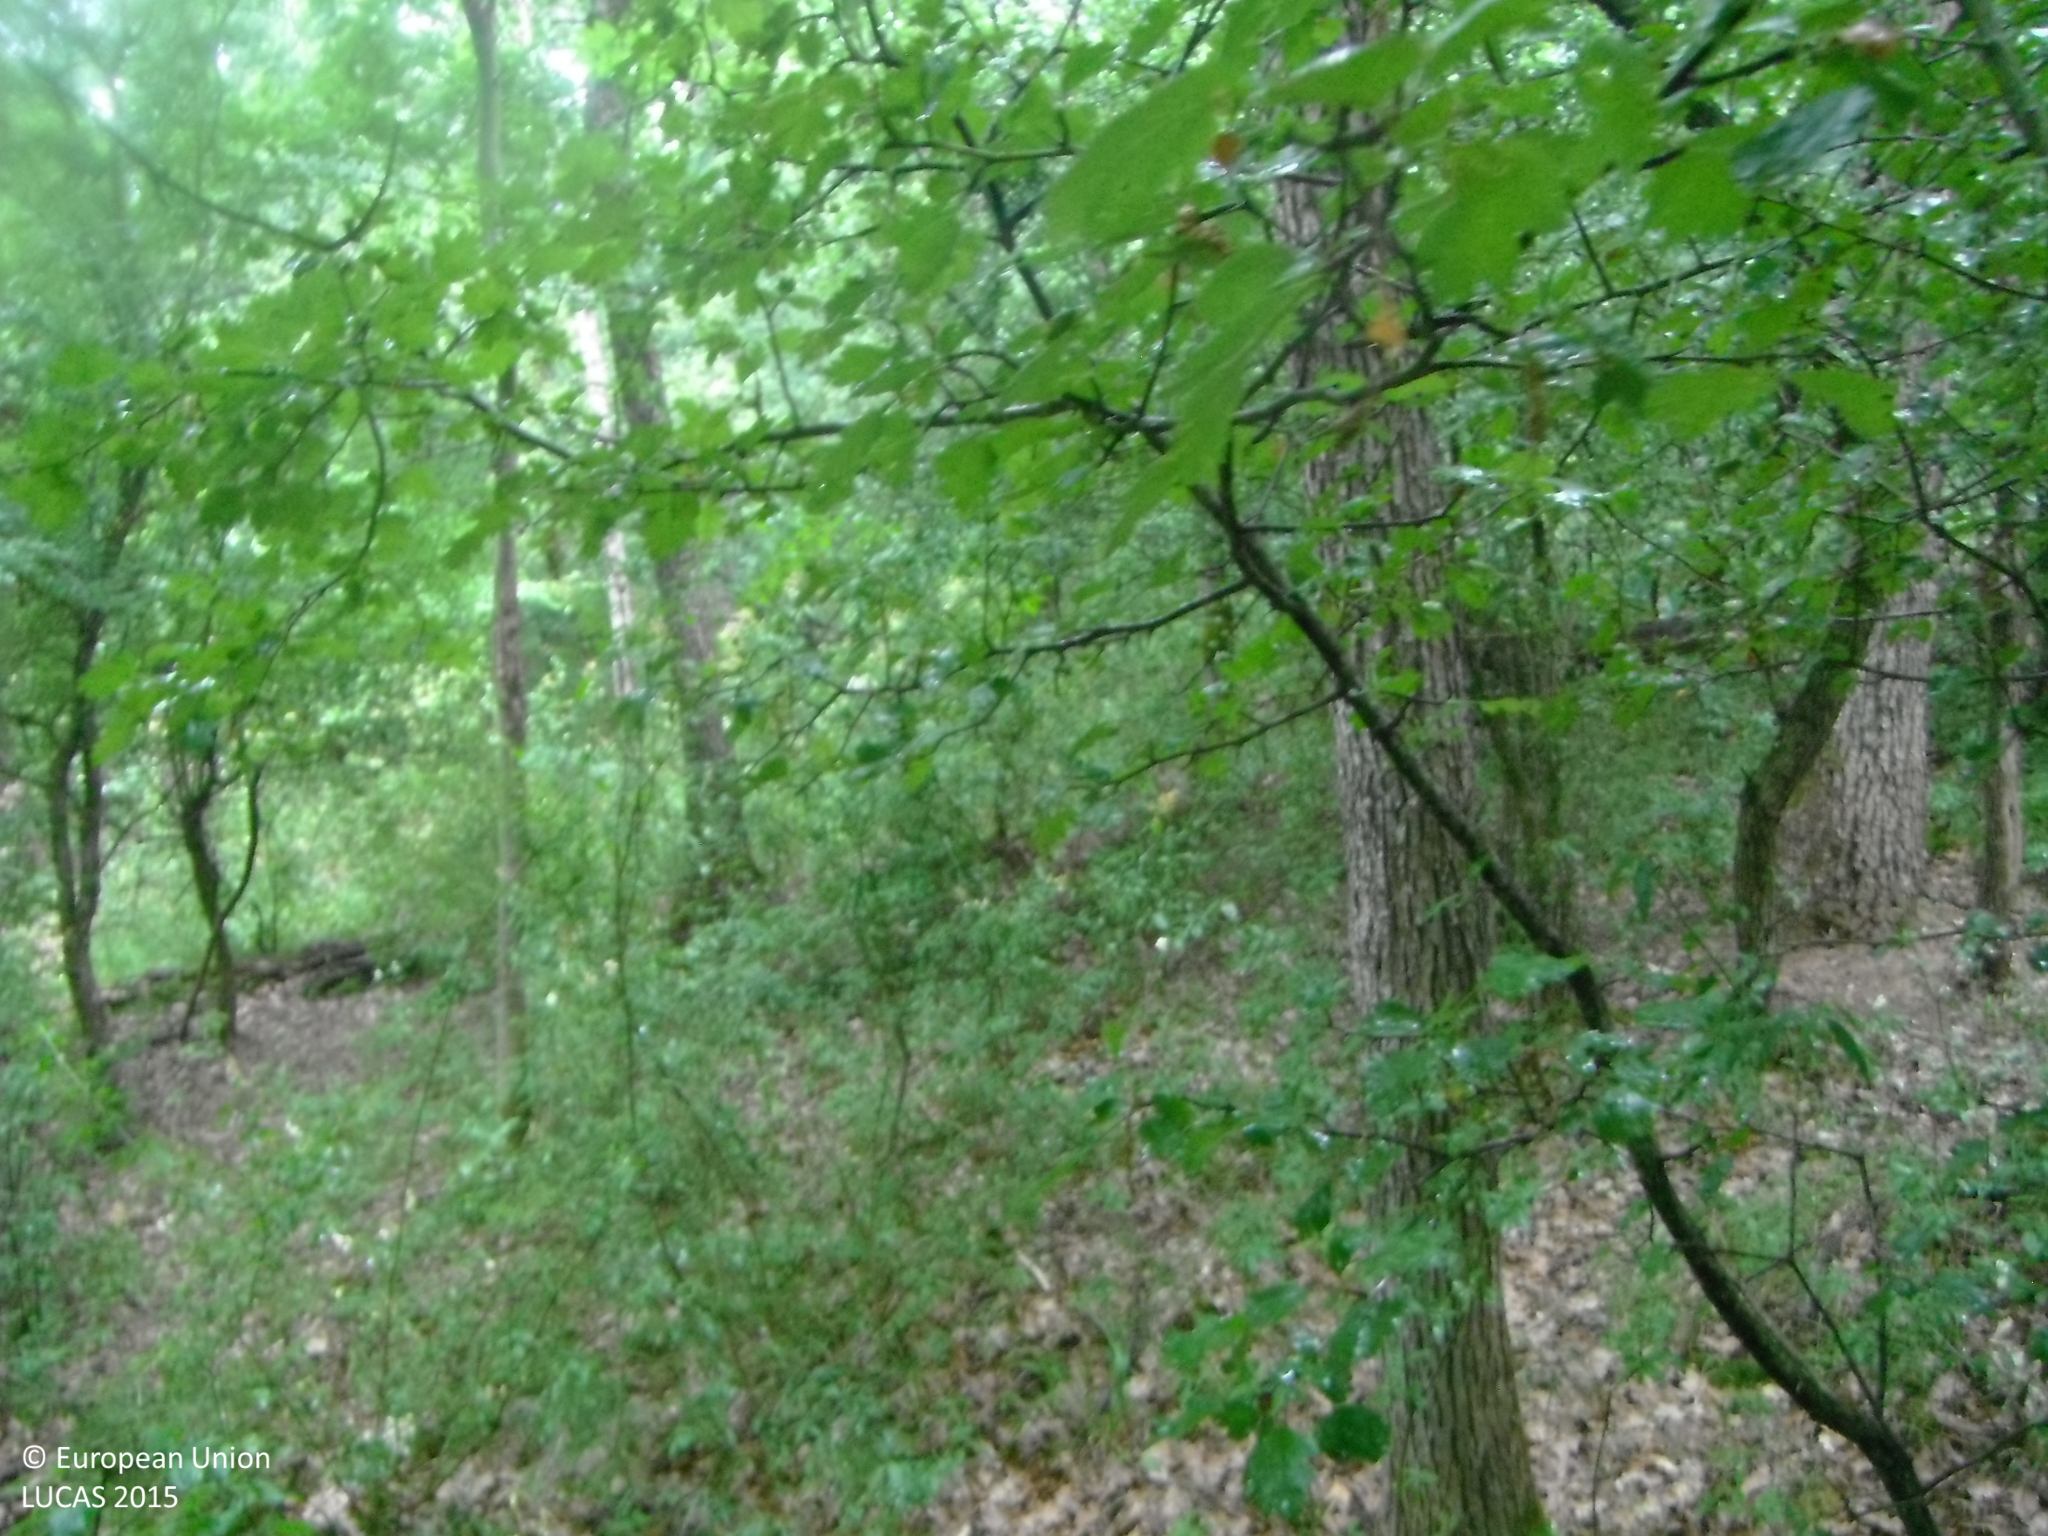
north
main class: Woodland
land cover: Broadleaved woodland
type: mesophytic deciduous forest
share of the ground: > 75 %
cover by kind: broadleaved forest trees 85 %, herbaceous plants 10 %, shrubs 5 %
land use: Forestry
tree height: > 5 m
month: June
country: SK
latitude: 48.7204
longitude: 18.3486
